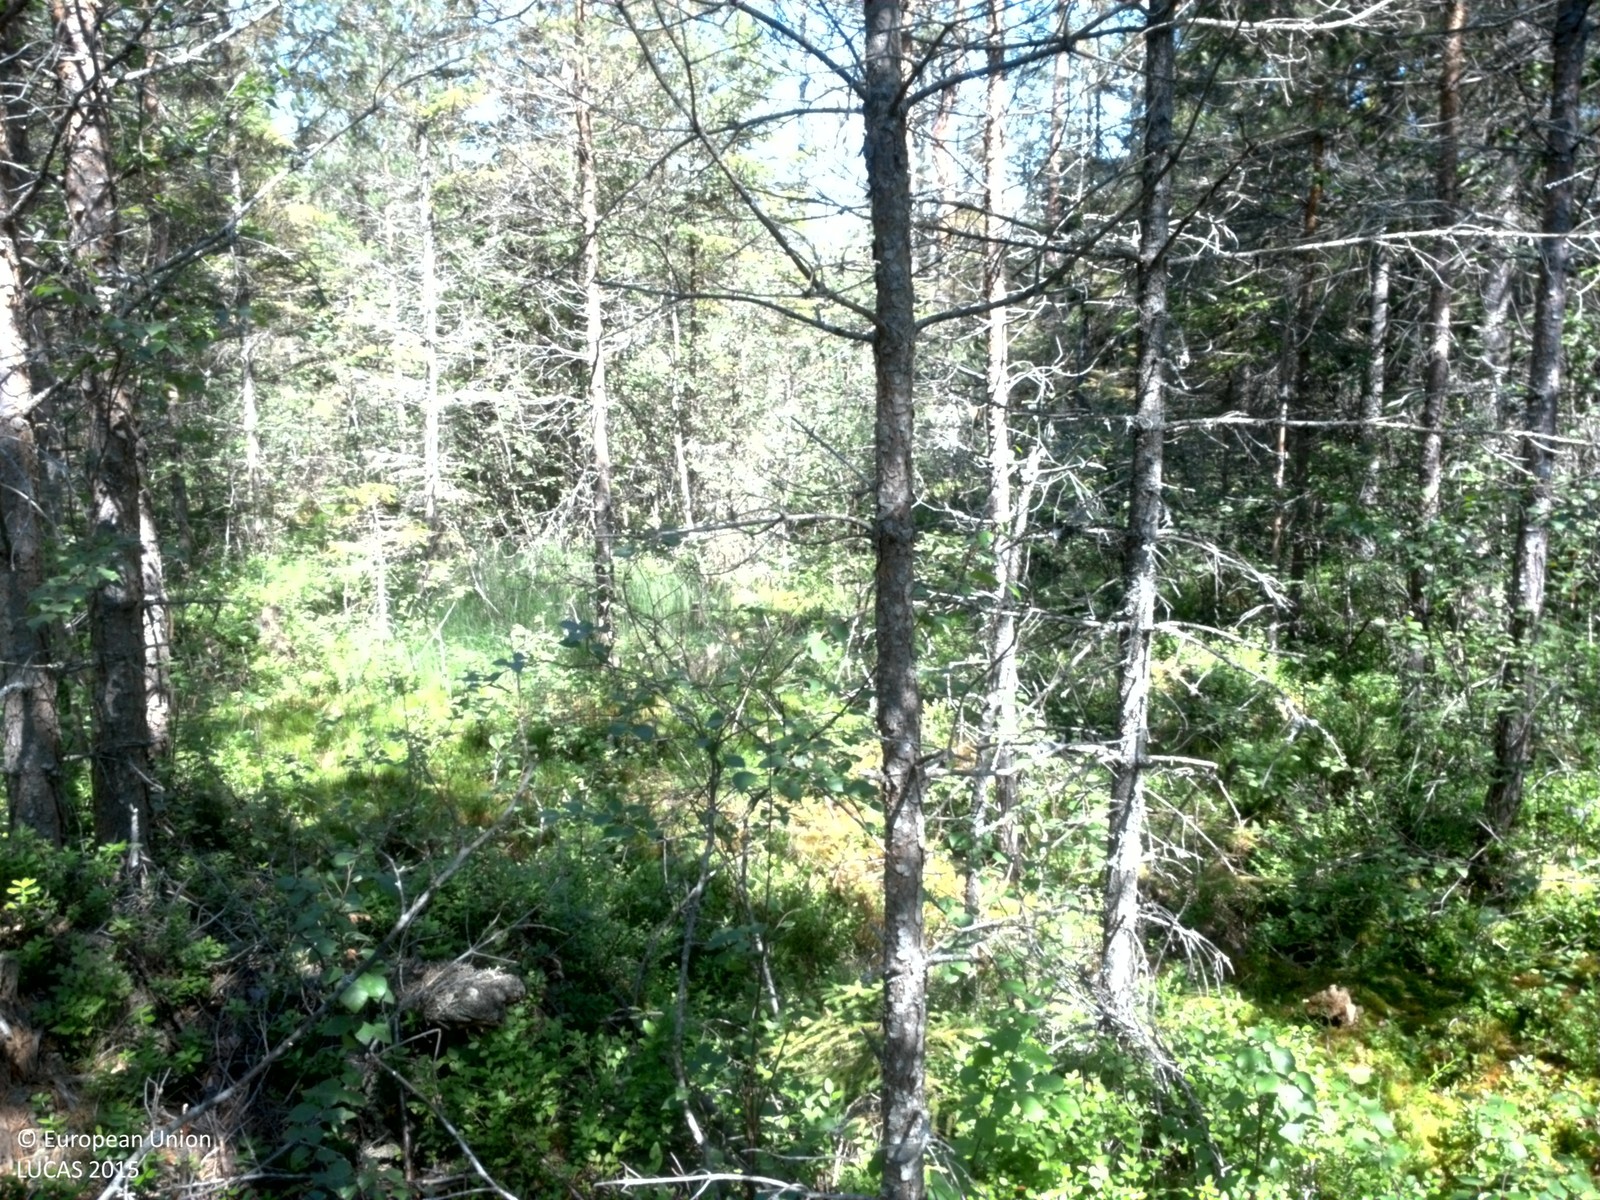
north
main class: Woodland
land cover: Other coniferous woodland
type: boreal forest
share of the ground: 50 - 75 %
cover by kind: coniferous forest trees 60 %, broadleaved forest trees 10 %, shrubs 10 %, herbaceous plants 10 %, lichens and mosses 10 %
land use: Forestry
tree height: > 5 m
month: July
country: SE
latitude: 59.6327
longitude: 14.7255
